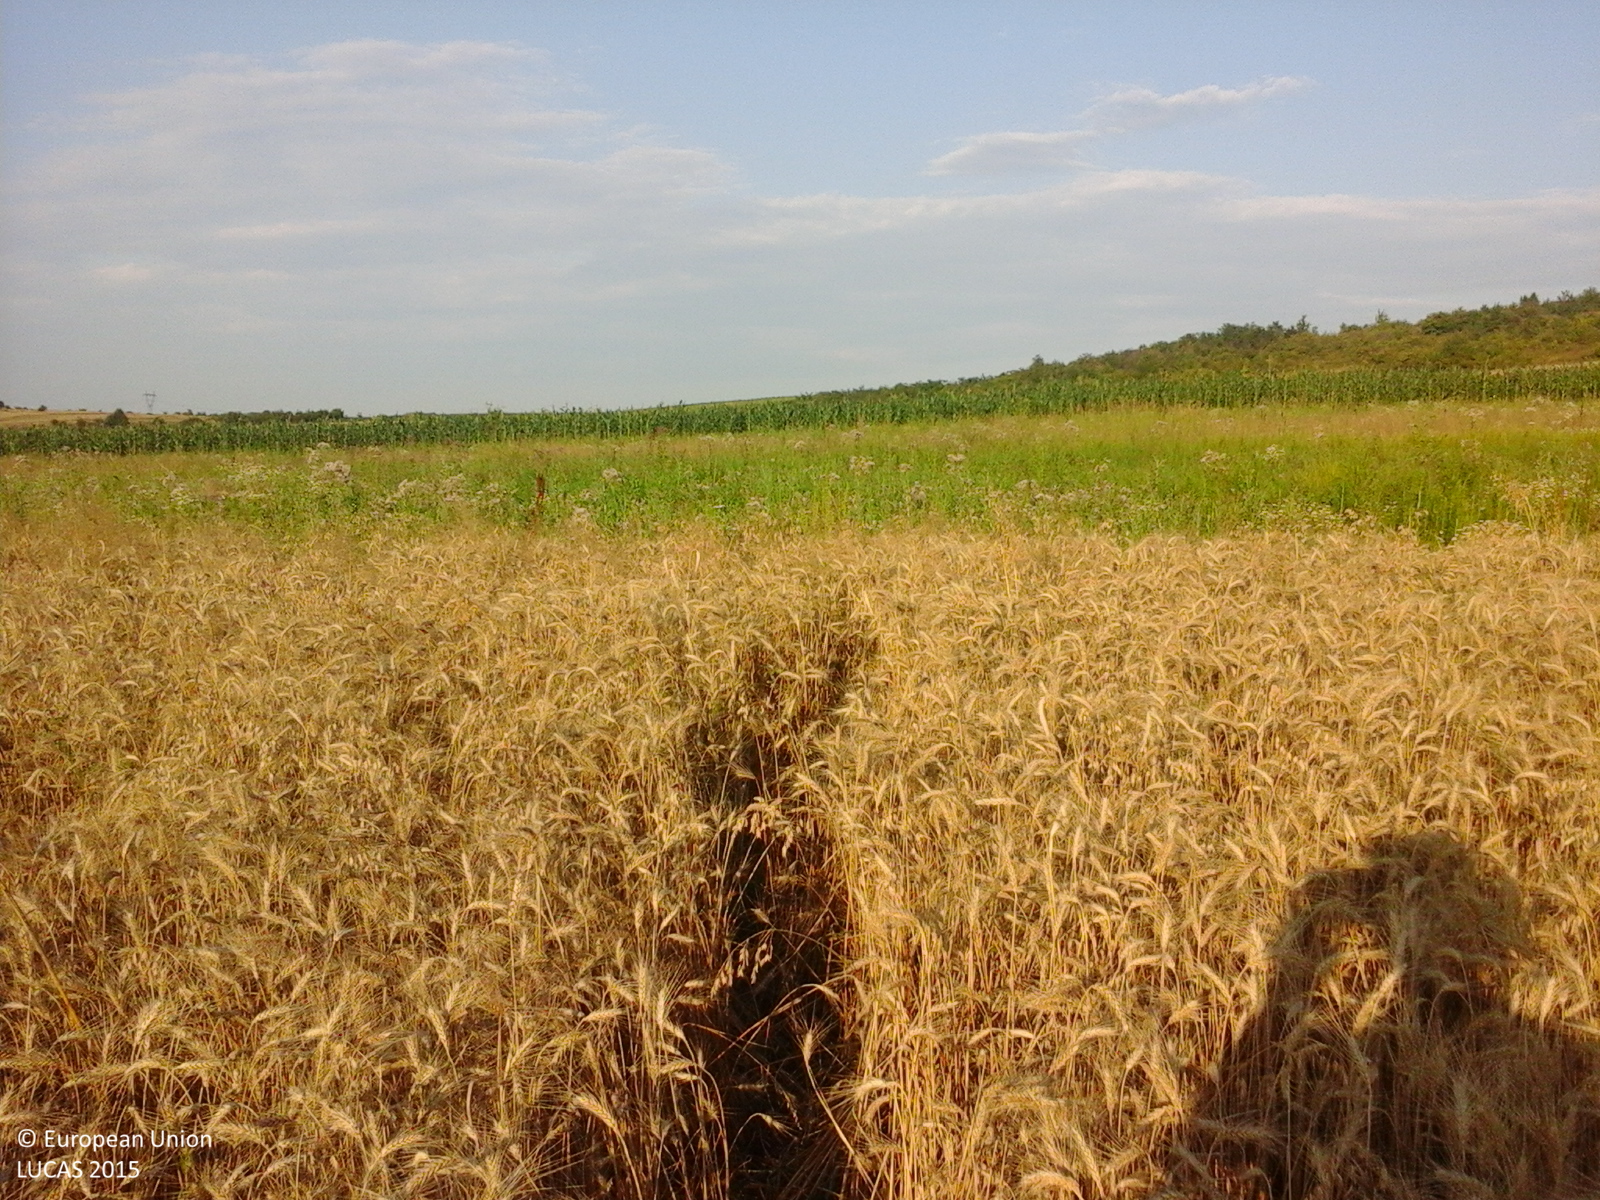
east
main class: Cropland
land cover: Common wheat
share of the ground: > 75 %
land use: Agriculture (excluding fallow land and kitchen gardens)
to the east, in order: Common wheat; Spontaneously vegetated surfaces; Maize; Oats; Maize; Other leguminous and mixtures for fodder; Common wheat; Maize; Grassland with sparse tree/shrub cover; Oats; Spontaneously vegetated surfaces
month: July
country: RO
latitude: 44.5467
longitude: 24.4063
